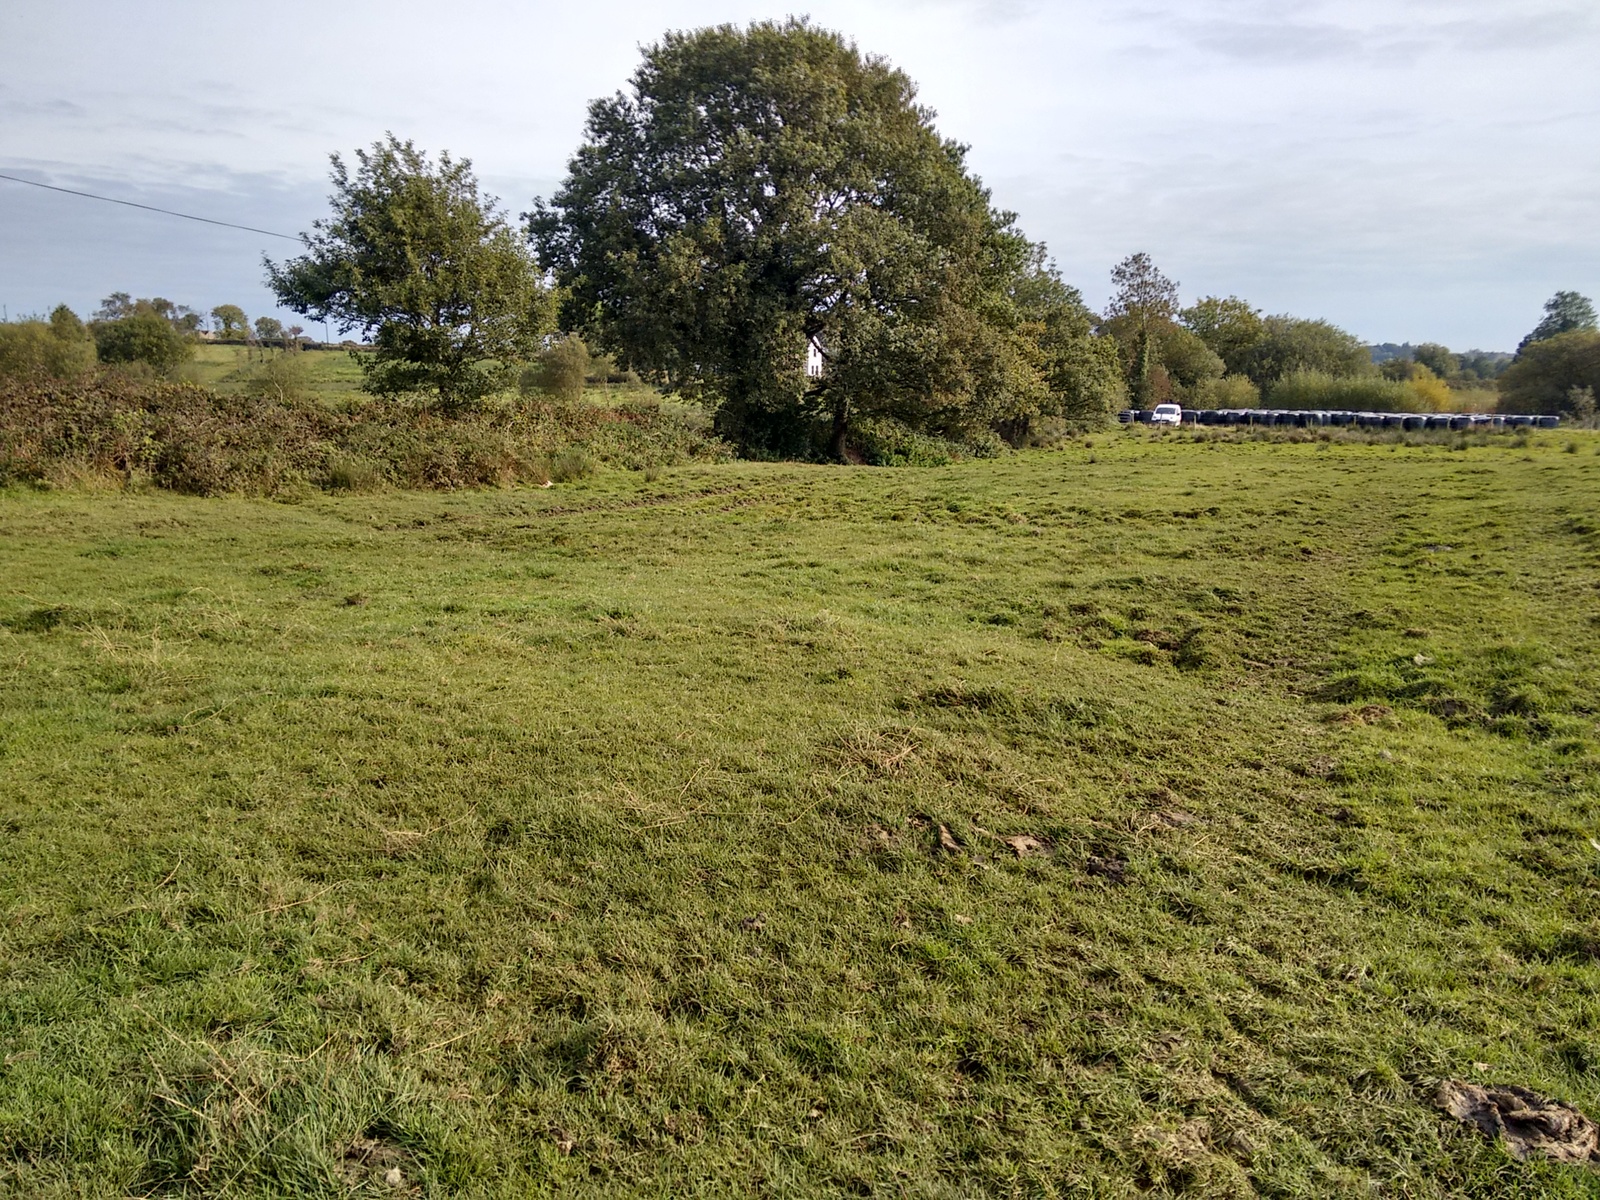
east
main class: Grassland
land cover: Grassland without tree/shrub cover
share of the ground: > 75 %
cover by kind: herbaceous plants 100 %
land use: Agriculture (excluding fallow land and kitchen gardens)
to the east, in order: Grassland without tree/shrub cover; Lines of trees; Fences; Grass margins; Paved roads, cycling and walking lanes; Grass margins; Fences; Managed hedges; Grassland without tree/shrub cover; Ditches and canals; Abandoned hedges; Fences; Grassland without tree/shrub cover; Ditches and canals; Fences; Grassland without tree/shrub cover; Tracks; Grassland without tree/shrub cover; Ditches and canals; Other structural elements; Paved roads, cycling and walking lanes; Single bushes/trees; Fences; Ditches and canals; Shruby margins; Grassland without tree/shrub cover
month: October
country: GB
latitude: 54.1317
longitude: -7.5594
